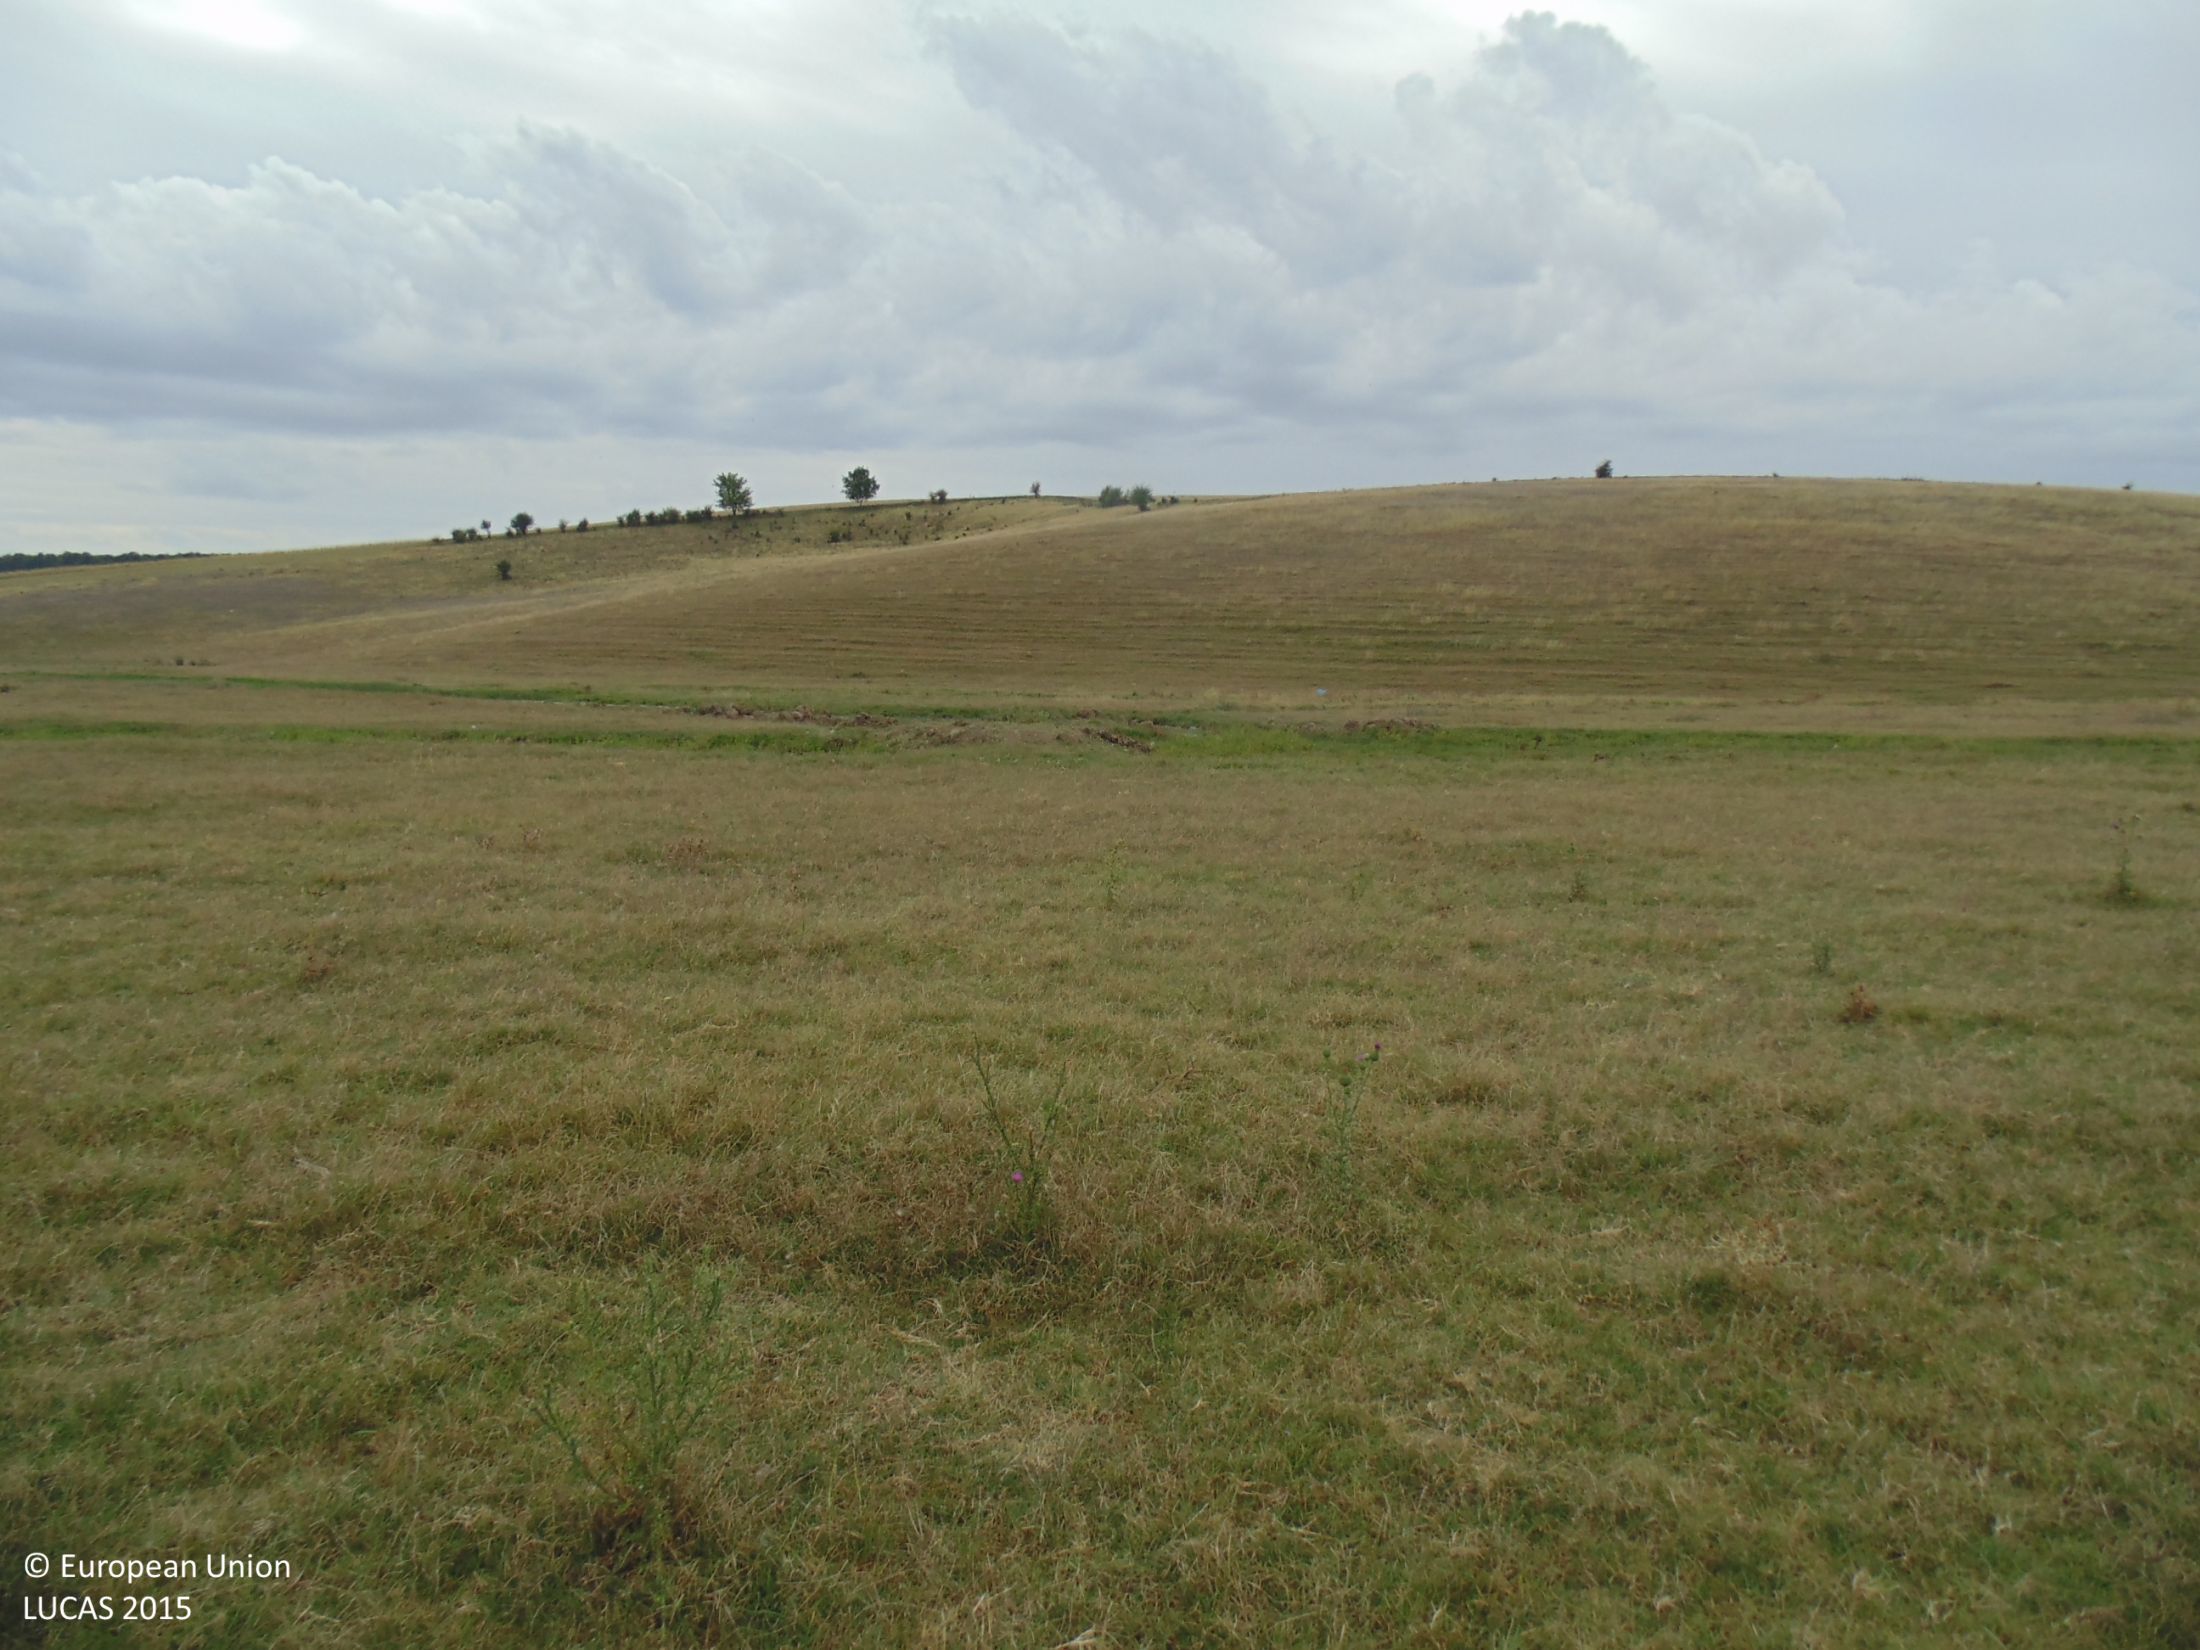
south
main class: Grassland
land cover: Grassland without tree/shrub cover
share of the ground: > 75 %
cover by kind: herbaceous plants 100 %
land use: Agriculture (excluding fallow land and kitchen gardens)
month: September
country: BG
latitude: 43.9586
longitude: 26.9325
